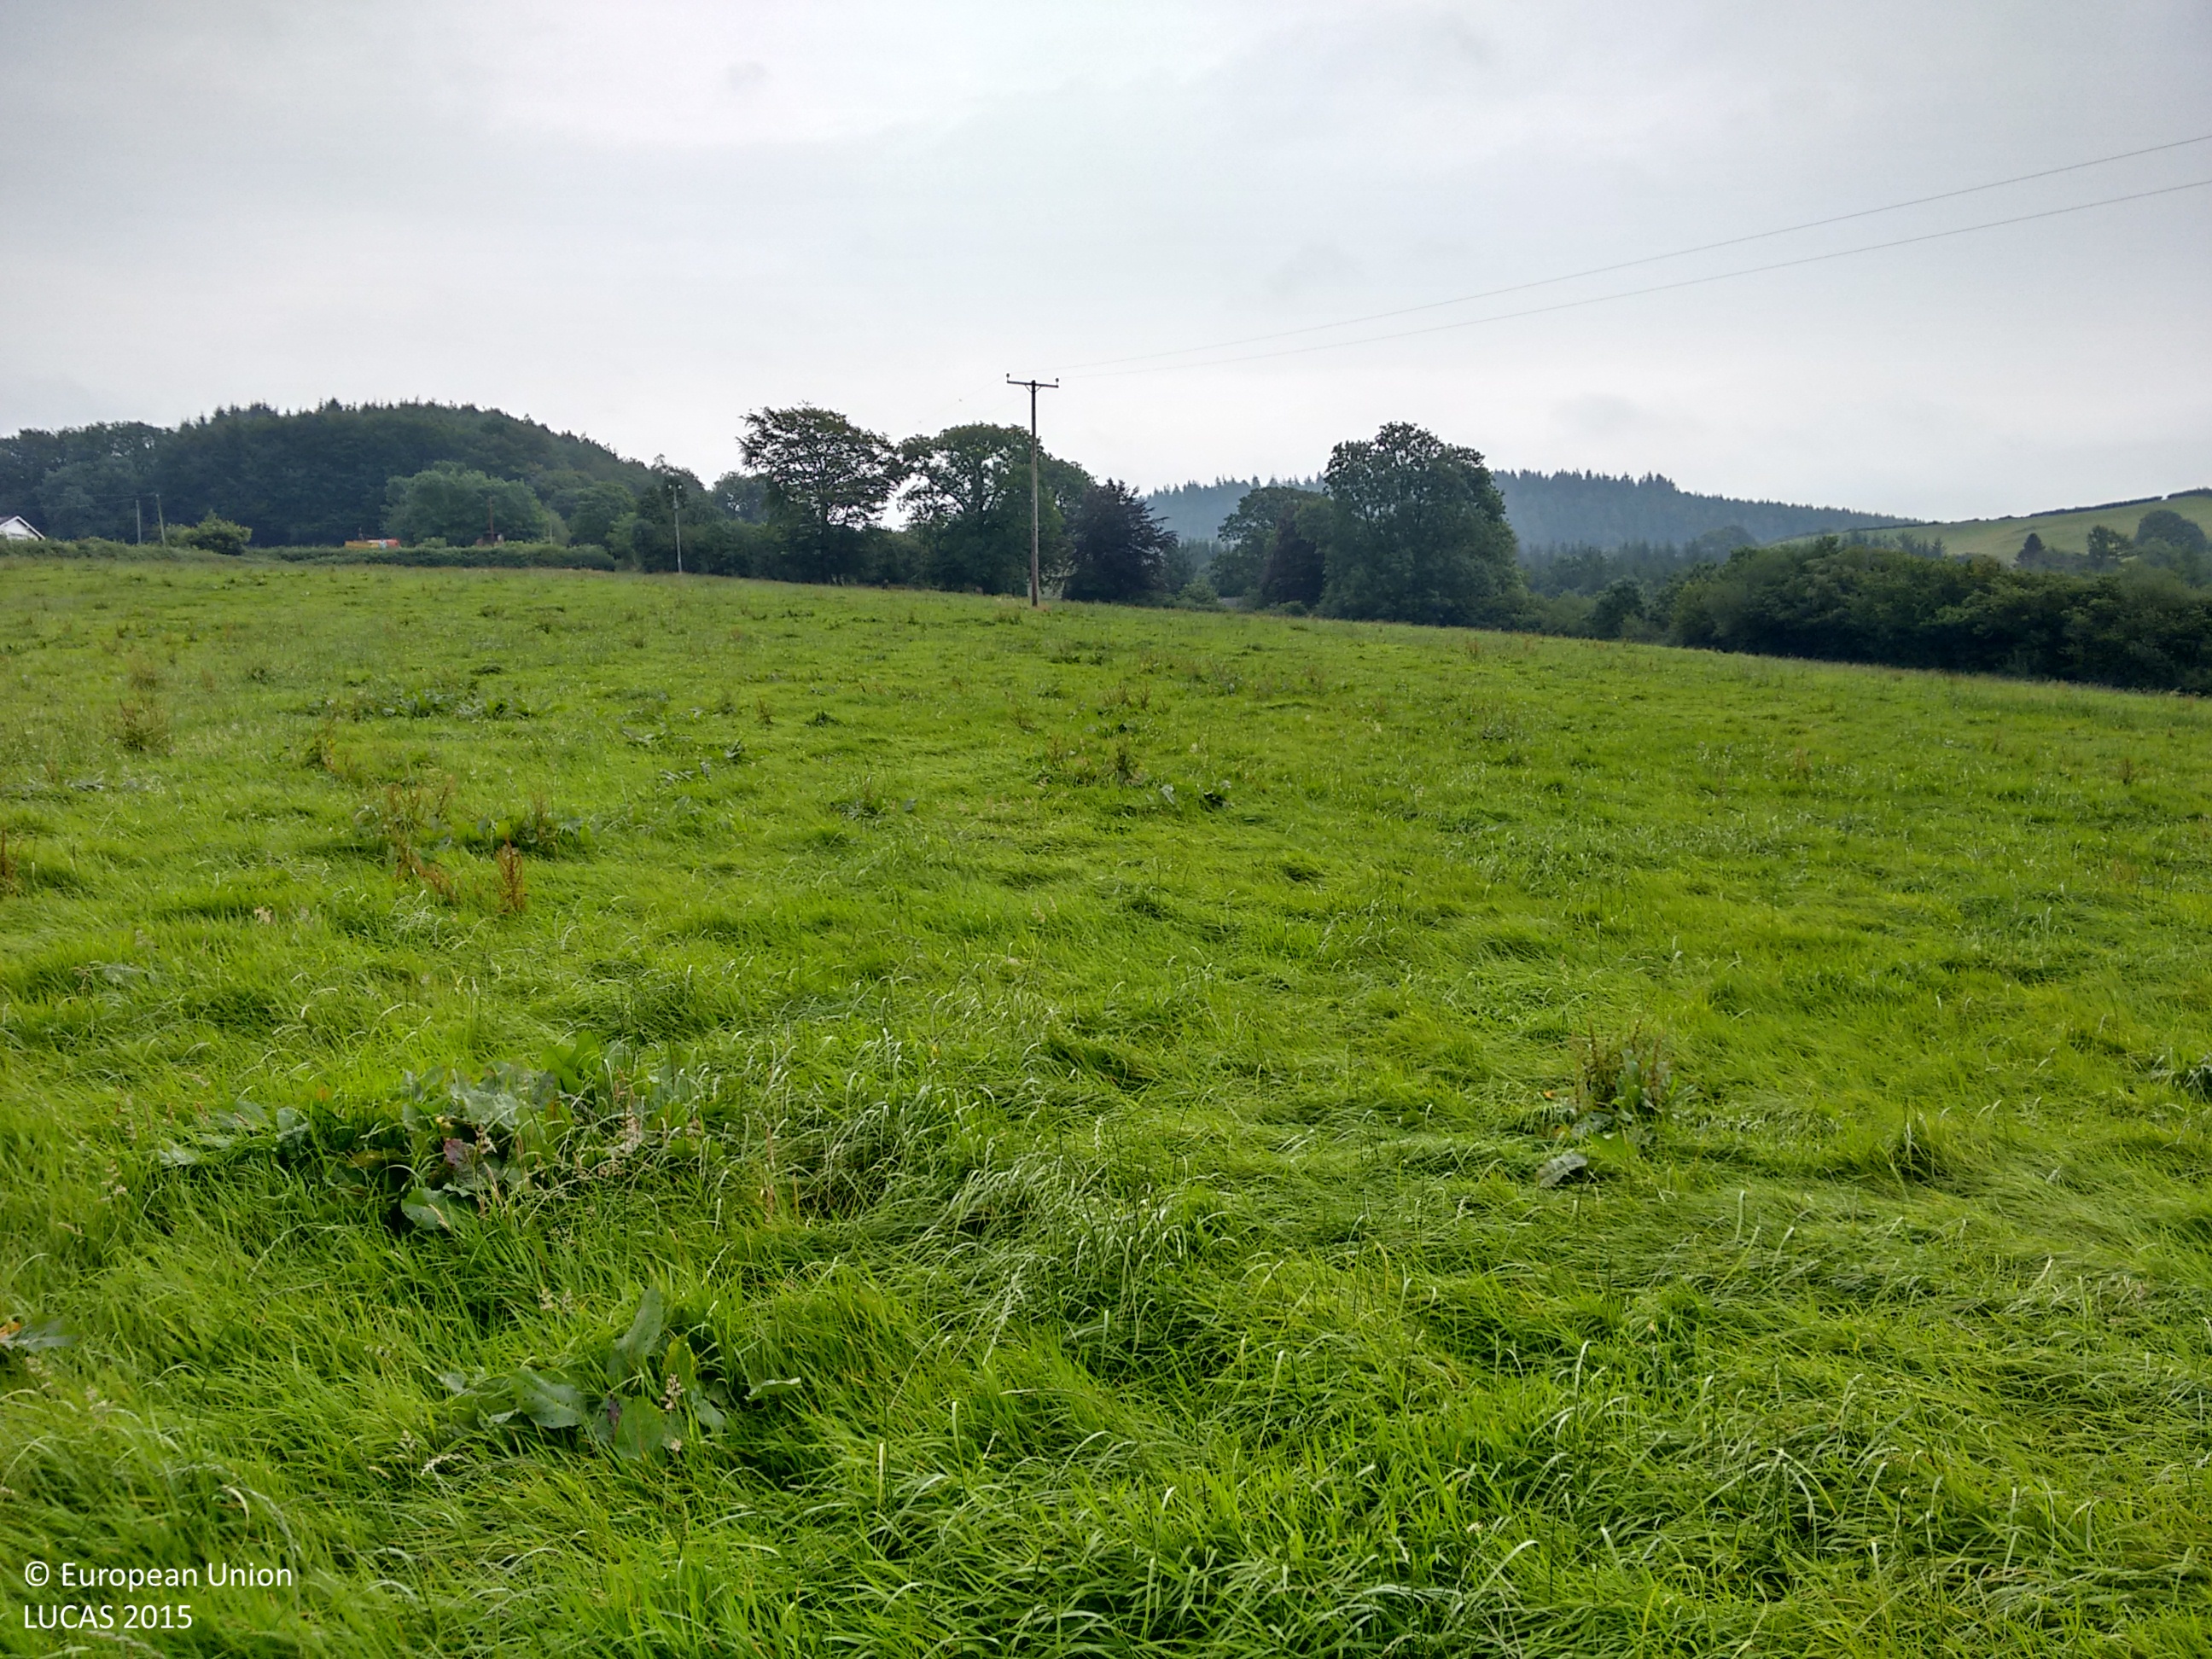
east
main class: Grassland
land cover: Grassland without tree/shrub cover
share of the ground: > 75 %
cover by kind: herbaceous plants 100 %
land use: Agriculture (excluding fallow land and kitchen gardens)
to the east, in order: Grassland without tree/shrub cover; Electric lines; Grassland without tree/shrub cover; Fences; Managed hedges; Single bushes/trees; Artificial constructions in urban areas
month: August
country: GB
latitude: 52.0437
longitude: -3.9296
